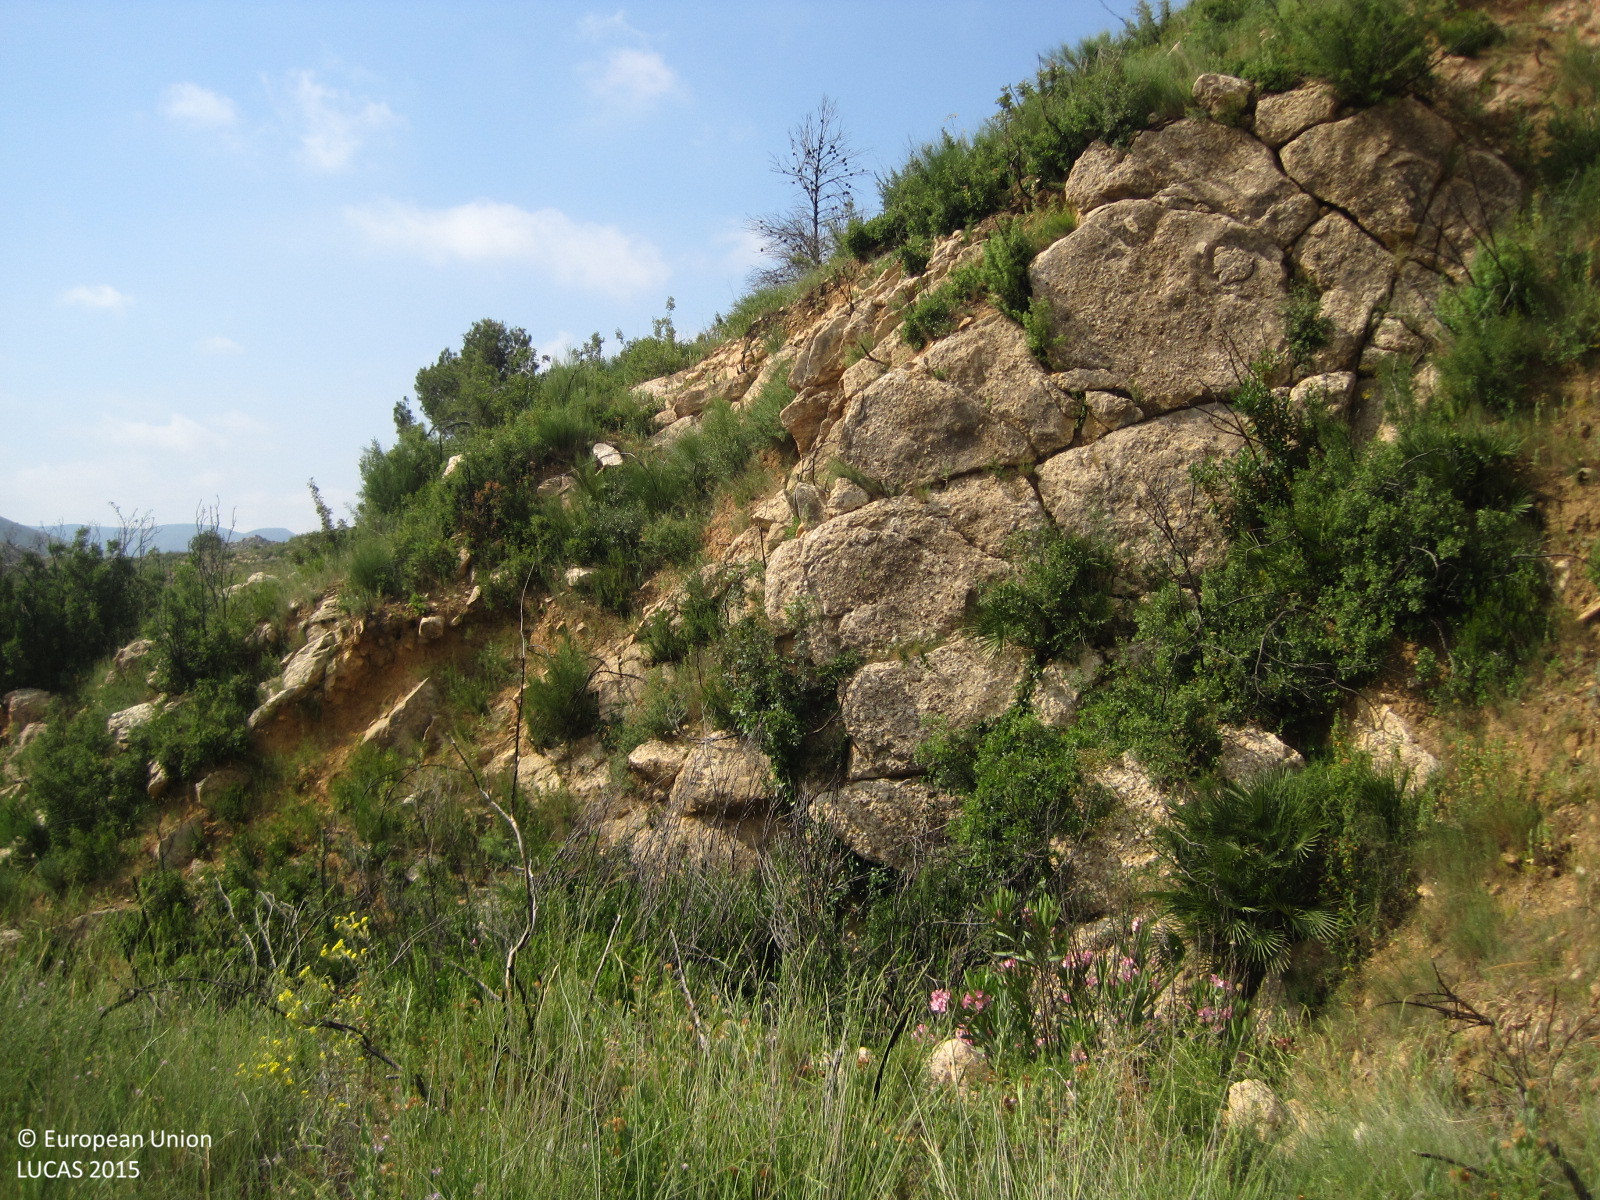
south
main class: Grassland
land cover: Grassland with sparse tree/shrub cover
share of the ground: > 75 %
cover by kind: herbaceous plants 85 %, shrubs 10 %, broadleaved forest trees 5 %
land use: Semi-natural and natural areas not in use
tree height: < 5 m
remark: Burnt area
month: June
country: ES
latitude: 39.3000
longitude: -0.8398
